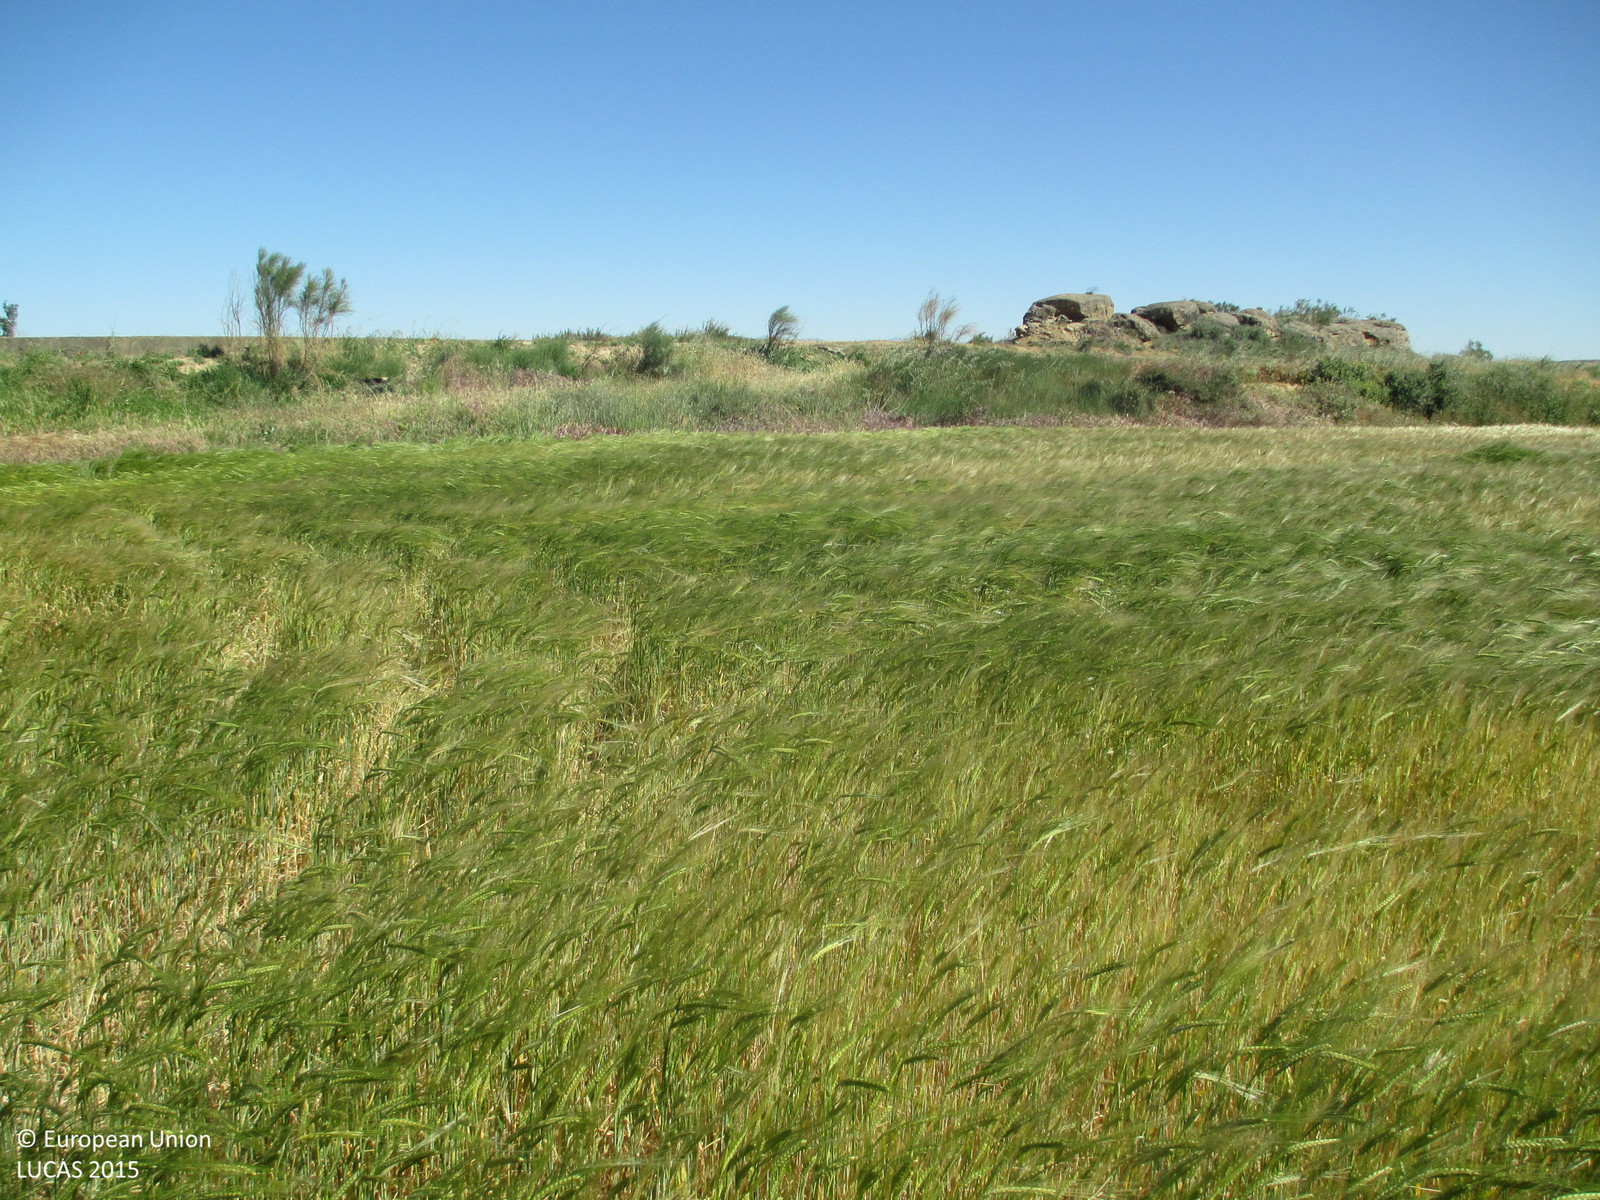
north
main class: Cropland
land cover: Barley
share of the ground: > 75 %
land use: Agriculture (excluding fallow land and kitchen gardens)
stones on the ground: < 10 %
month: May
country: ES
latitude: 41.8675
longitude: -0.1750
